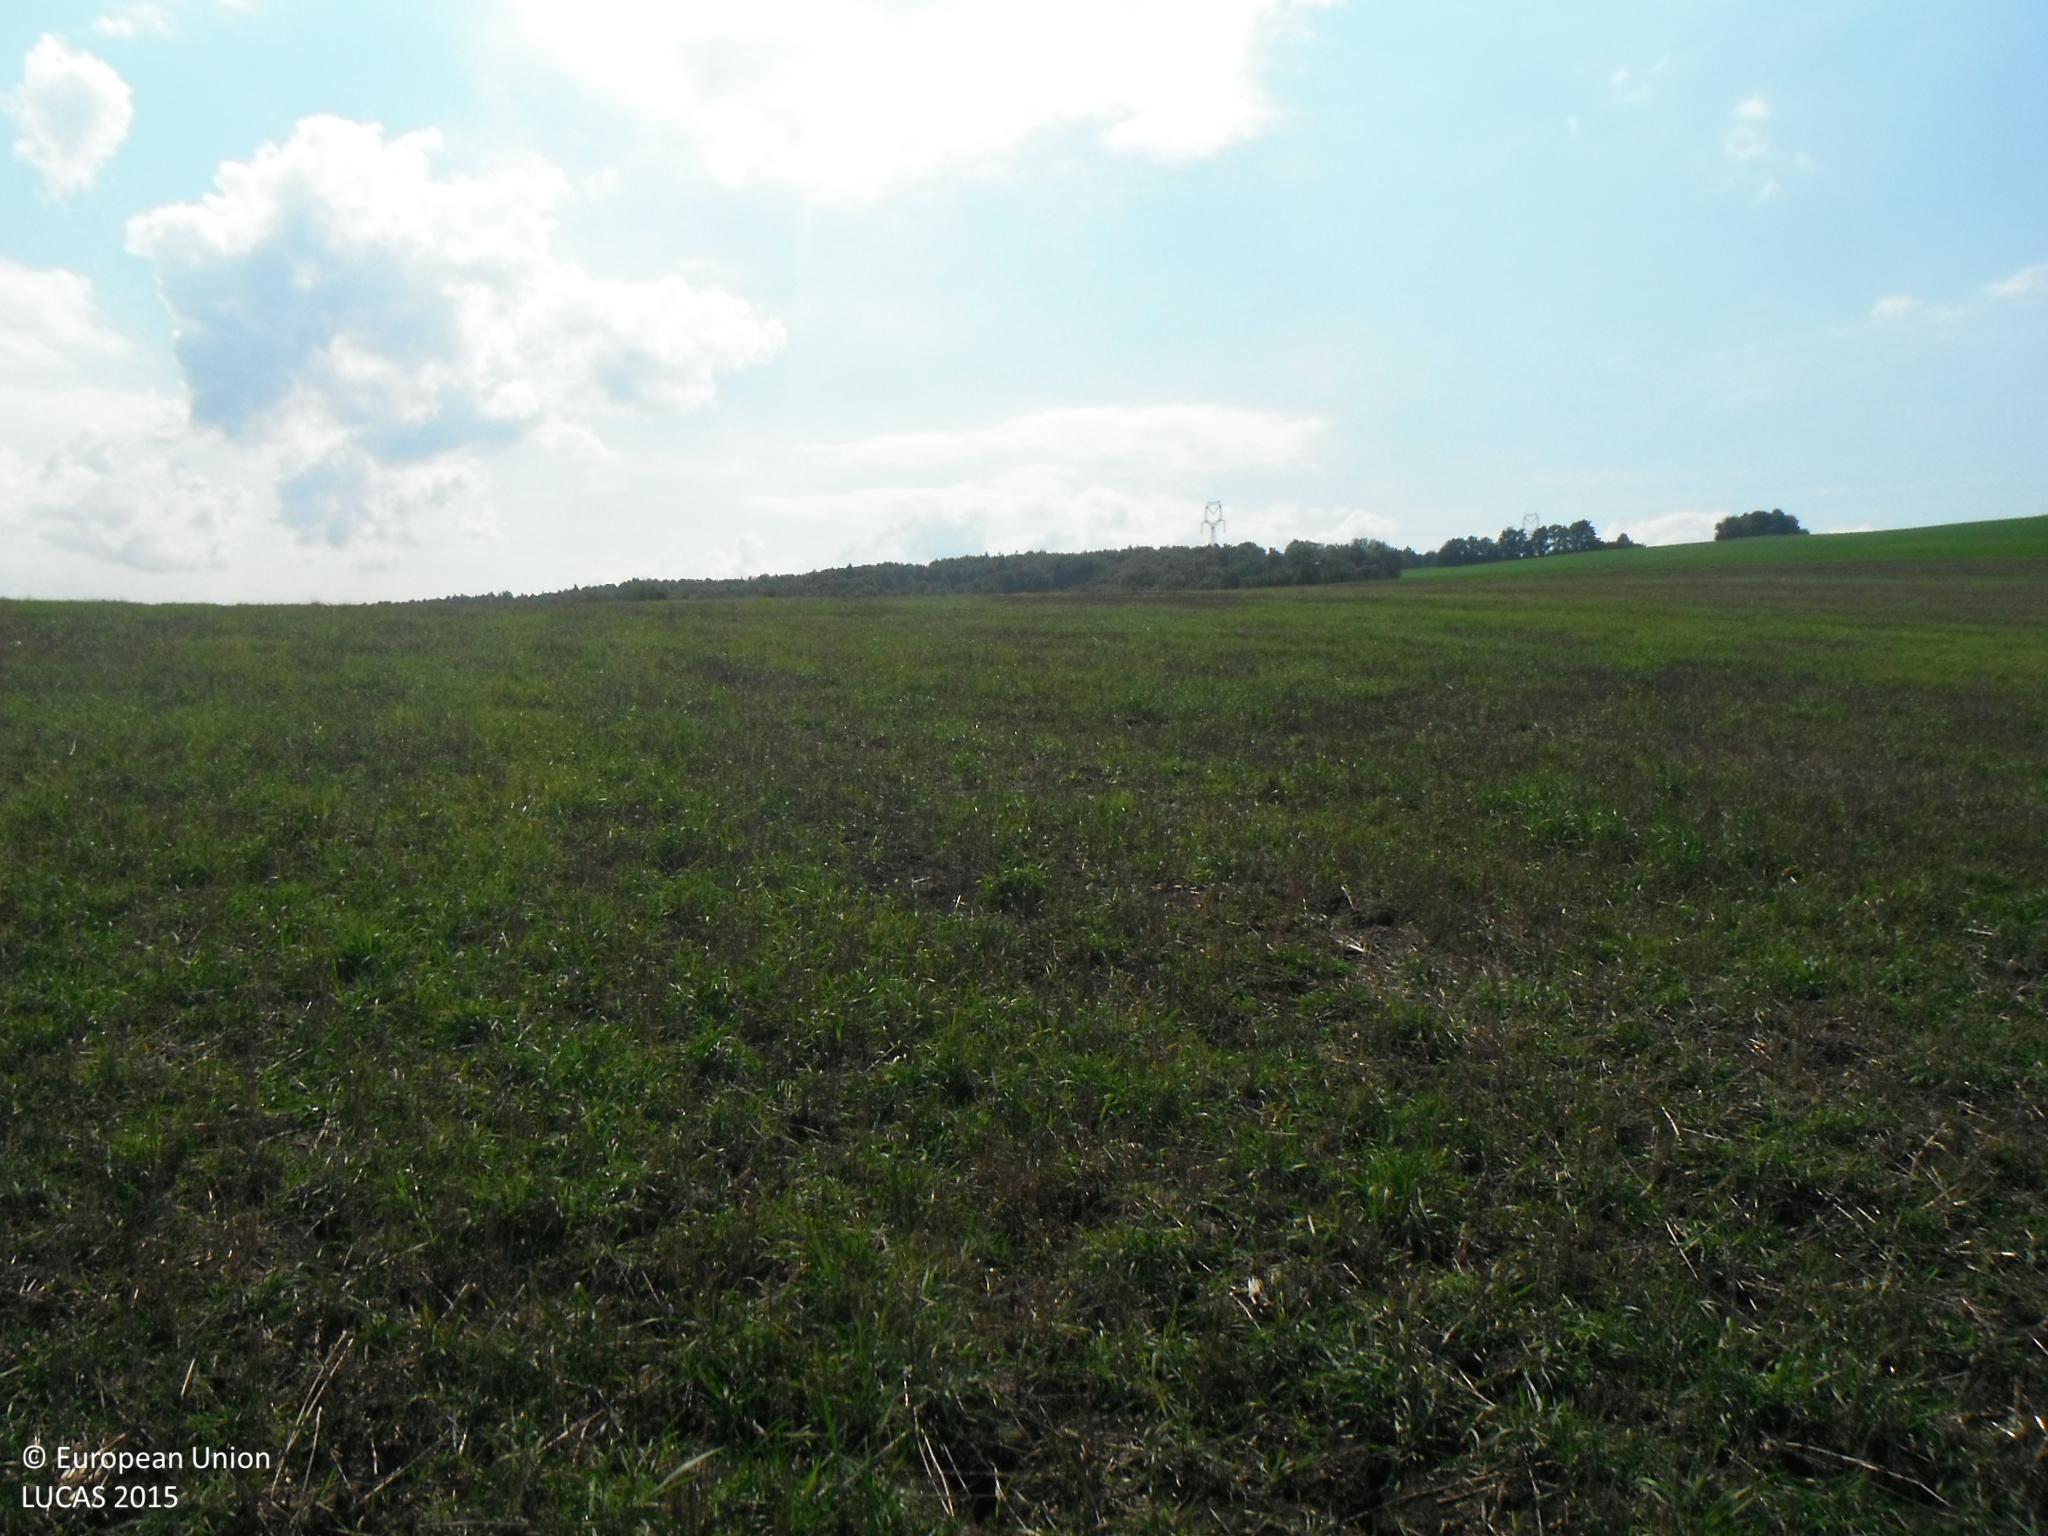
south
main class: Cropland
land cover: Common wheat
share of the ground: < 10 %
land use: Agriculture (excluding fallow land and kitchen gardens)
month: September
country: SK
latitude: 48.9428
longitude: 18.0289
